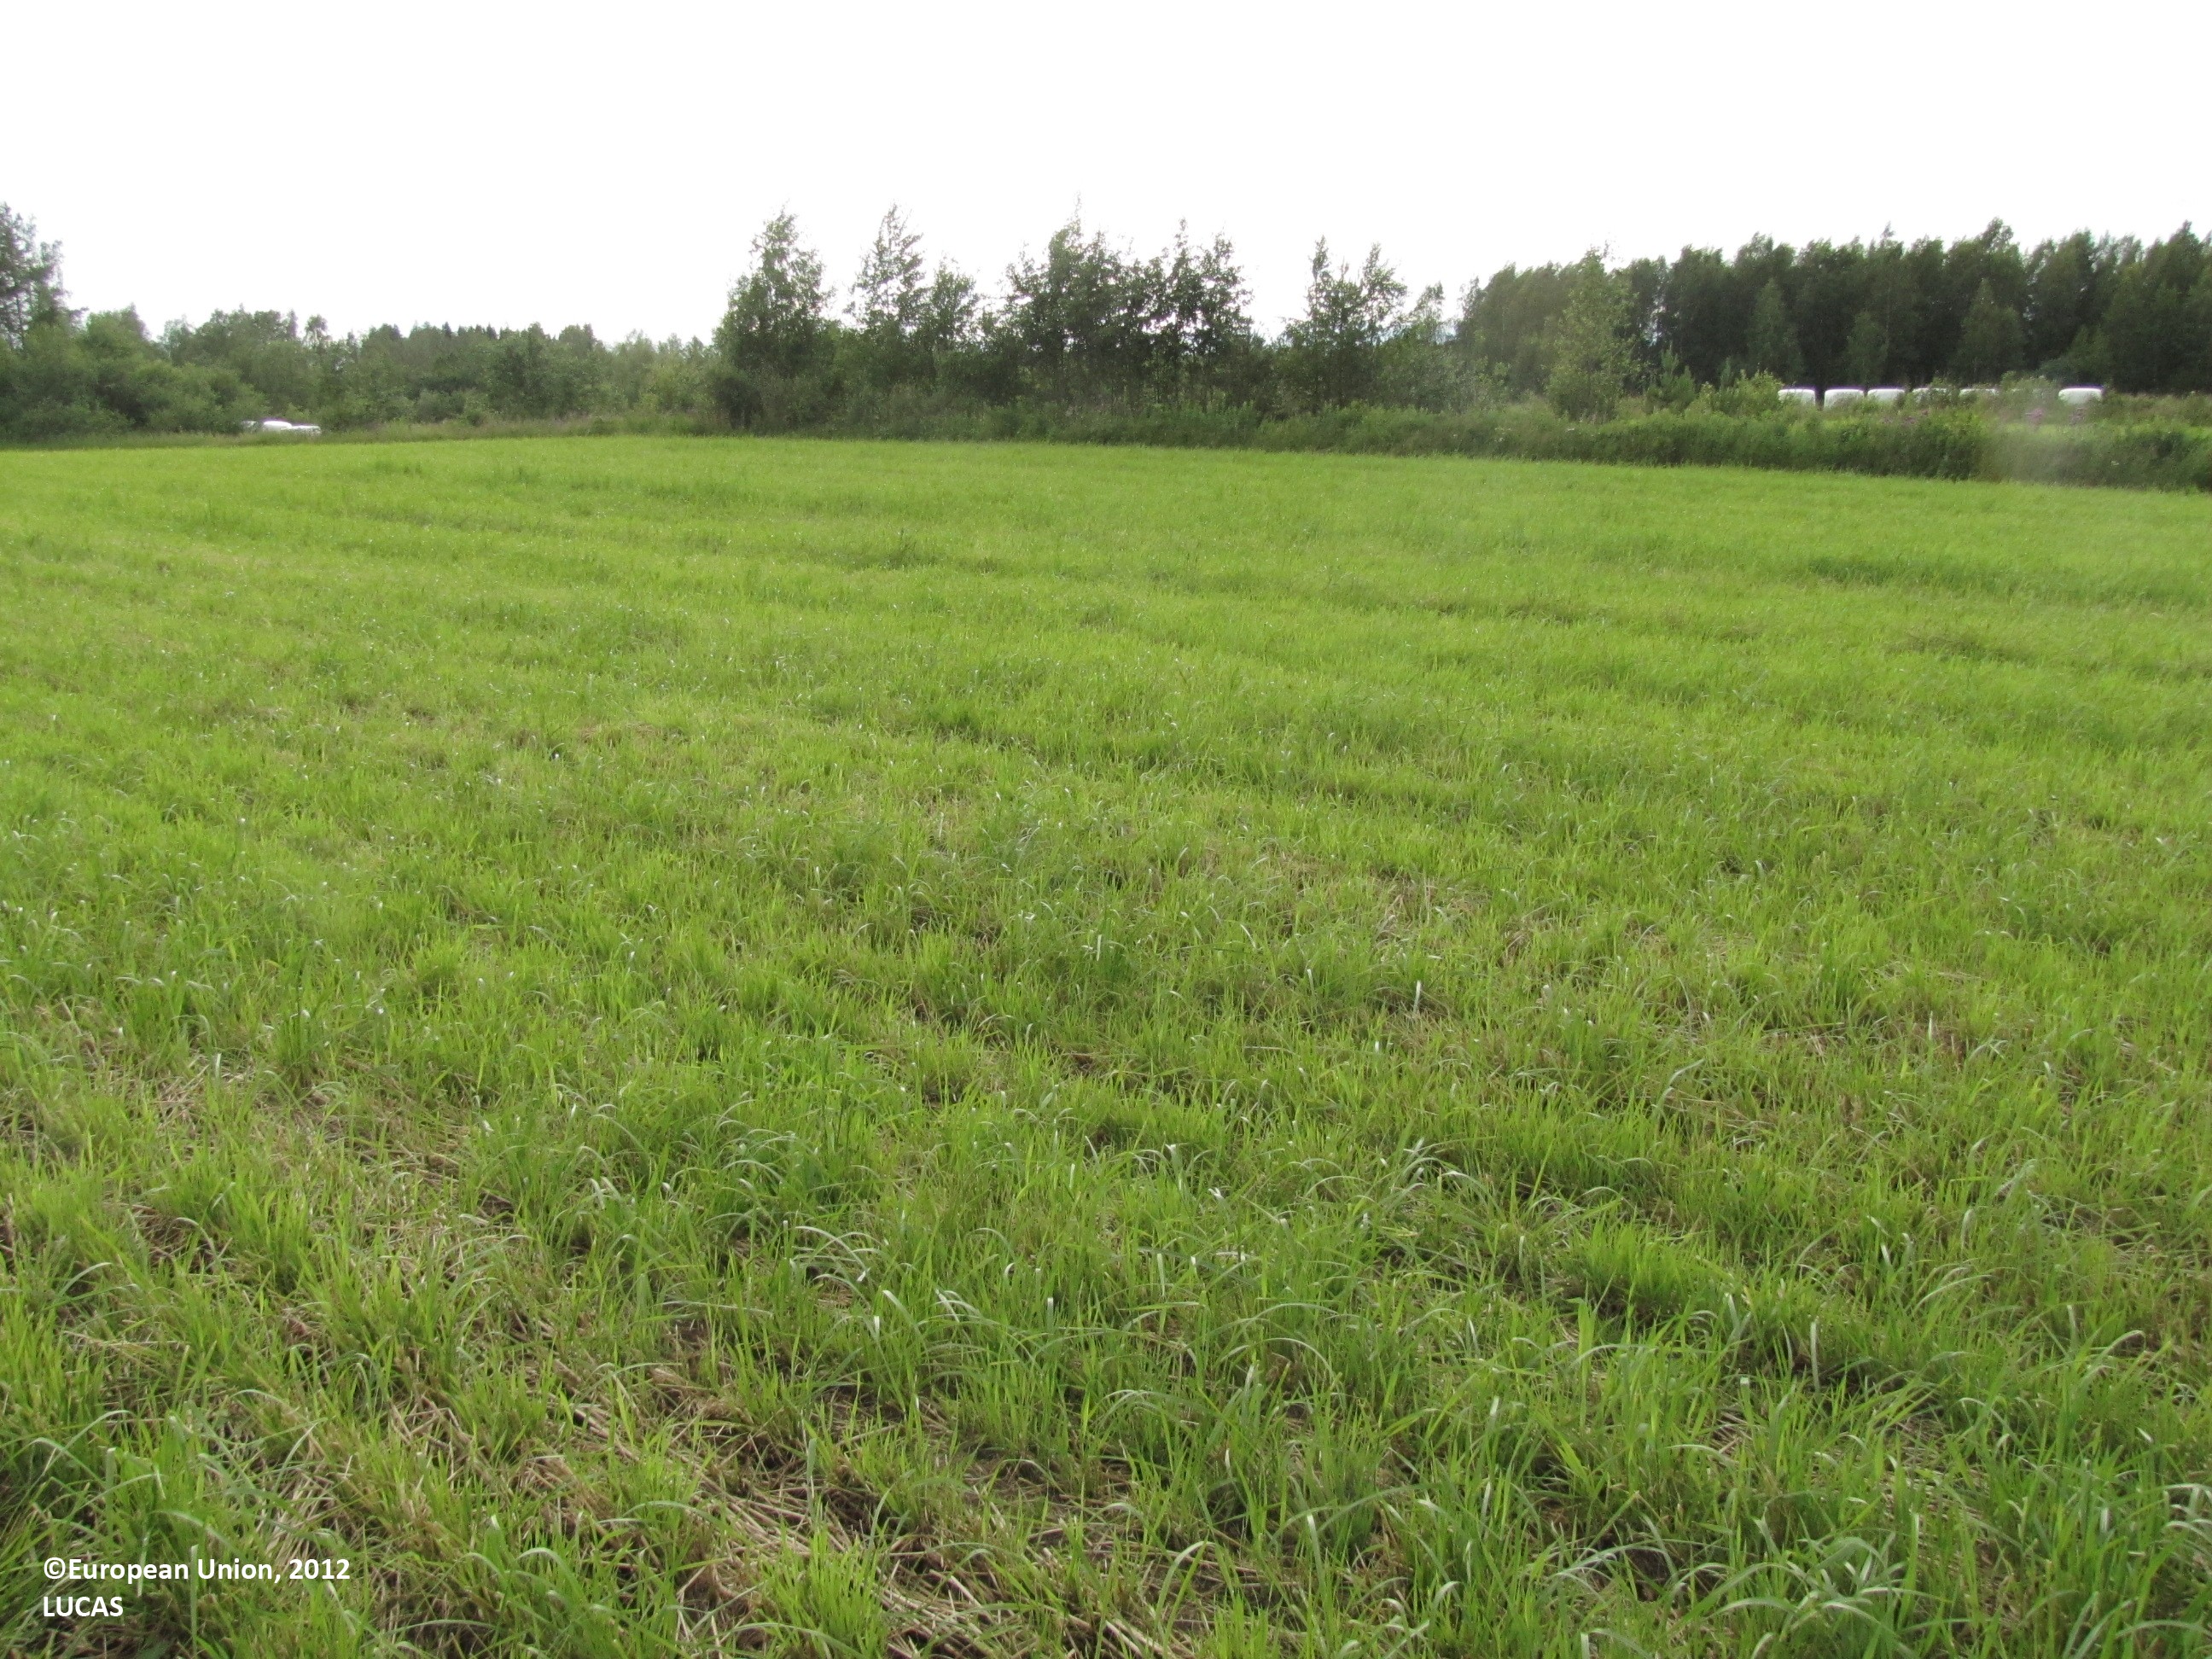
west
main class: Cropland
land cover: Temporary grasslands
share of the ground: > 75 %
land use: Agriculture (excluding fallow land and kitchen gardens)
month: July
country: FI
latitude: 62.4344
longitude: 23.9683
